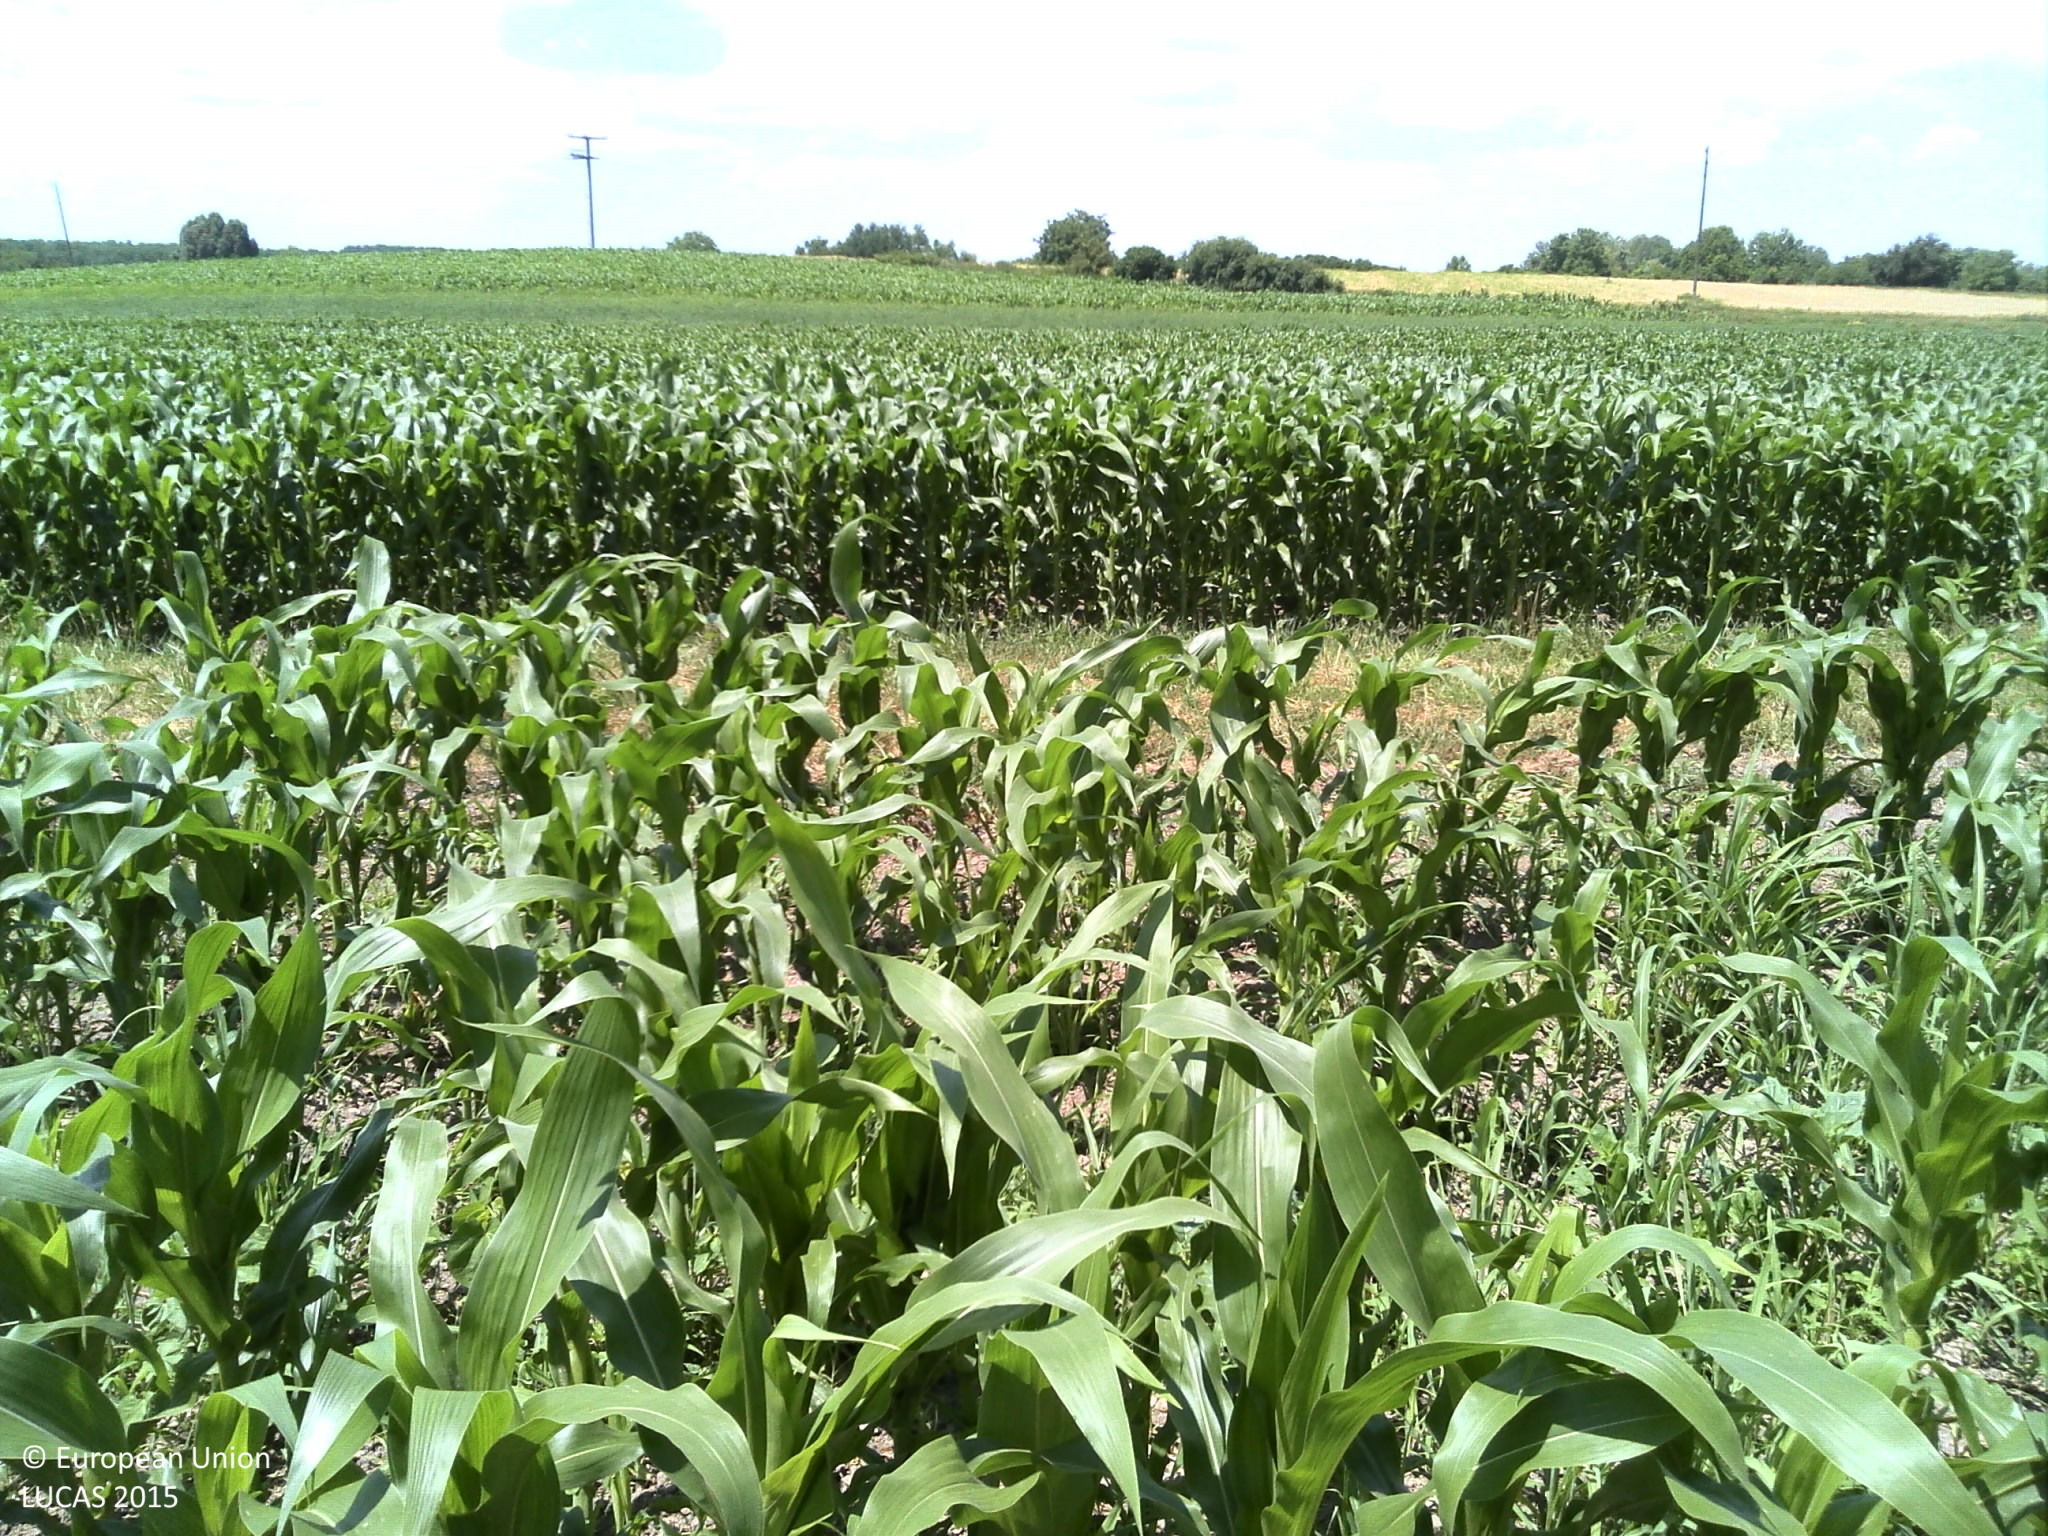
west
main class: Cropland
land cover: Maize
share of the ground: 25 - 50 %
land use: Agriculture (excluding fallow land and kitchen gardens)
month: June
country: HR
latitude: 45.7260
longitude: 18.6816
